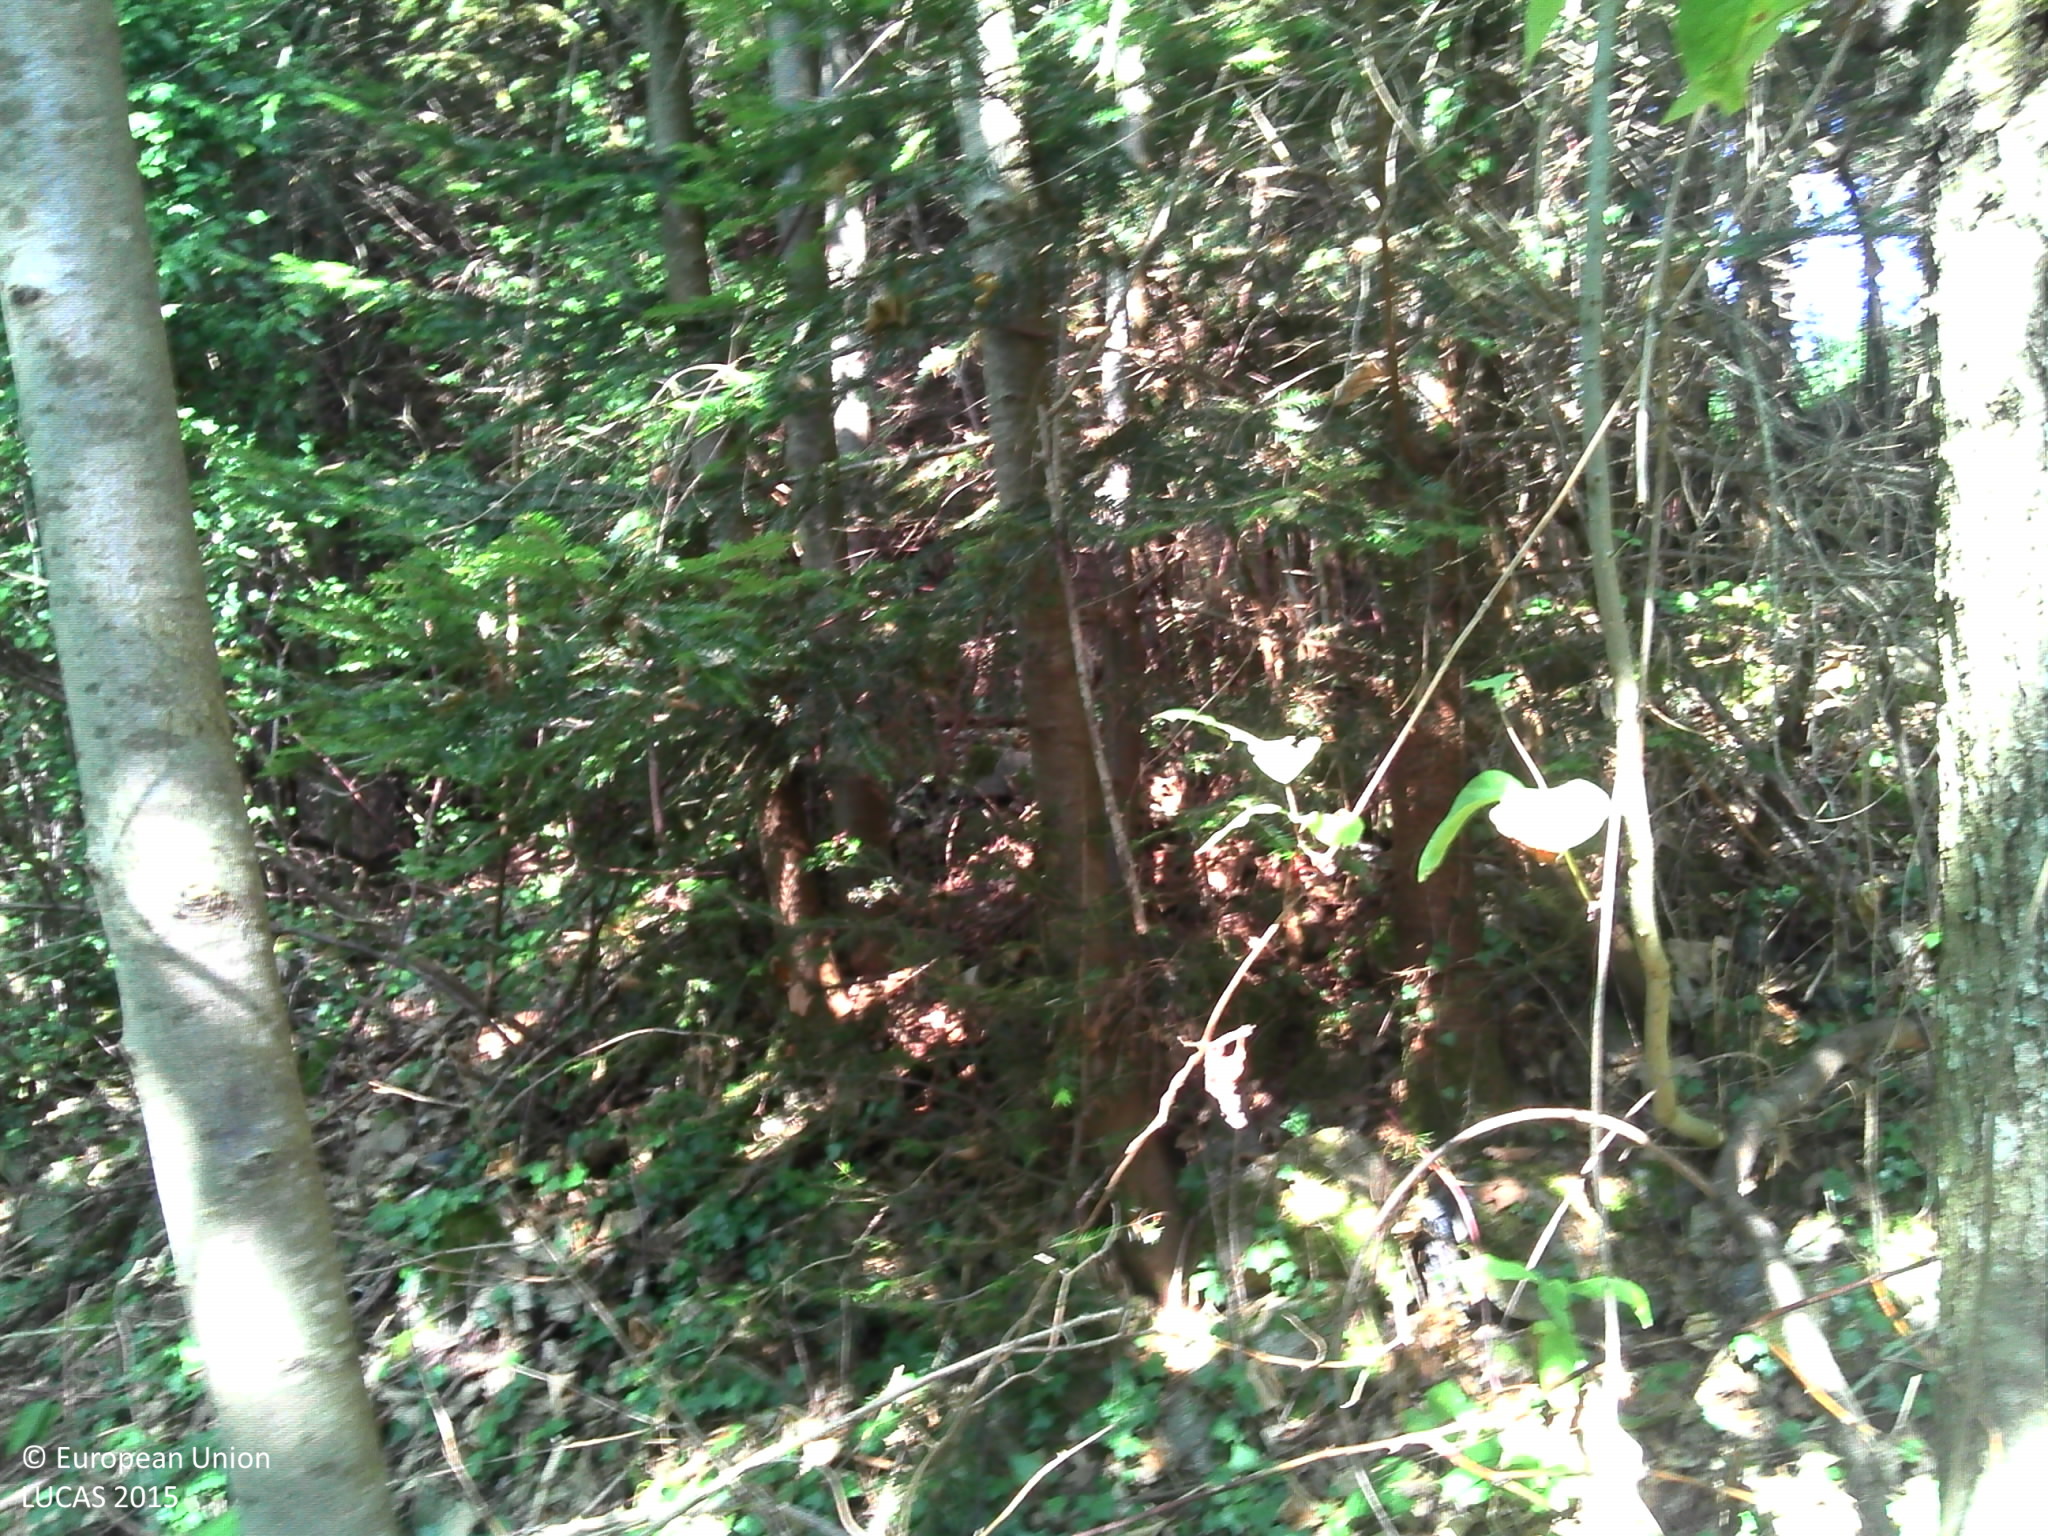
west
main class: Woodland
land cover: Spruce dominated mixed woodland
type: hemiboreal forest and nemoral coniferous forest and mixed broadleaved-coniferous forest
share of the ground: > 75 %
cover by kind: broadleaved forest trees 60 %, coniferous forest trees 20 %, herbaceous plants 20 %
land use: Semi-natural and natural areas not in use
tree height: < 5 m
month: August
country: FR
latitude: 46.1568
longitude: 4.5247
